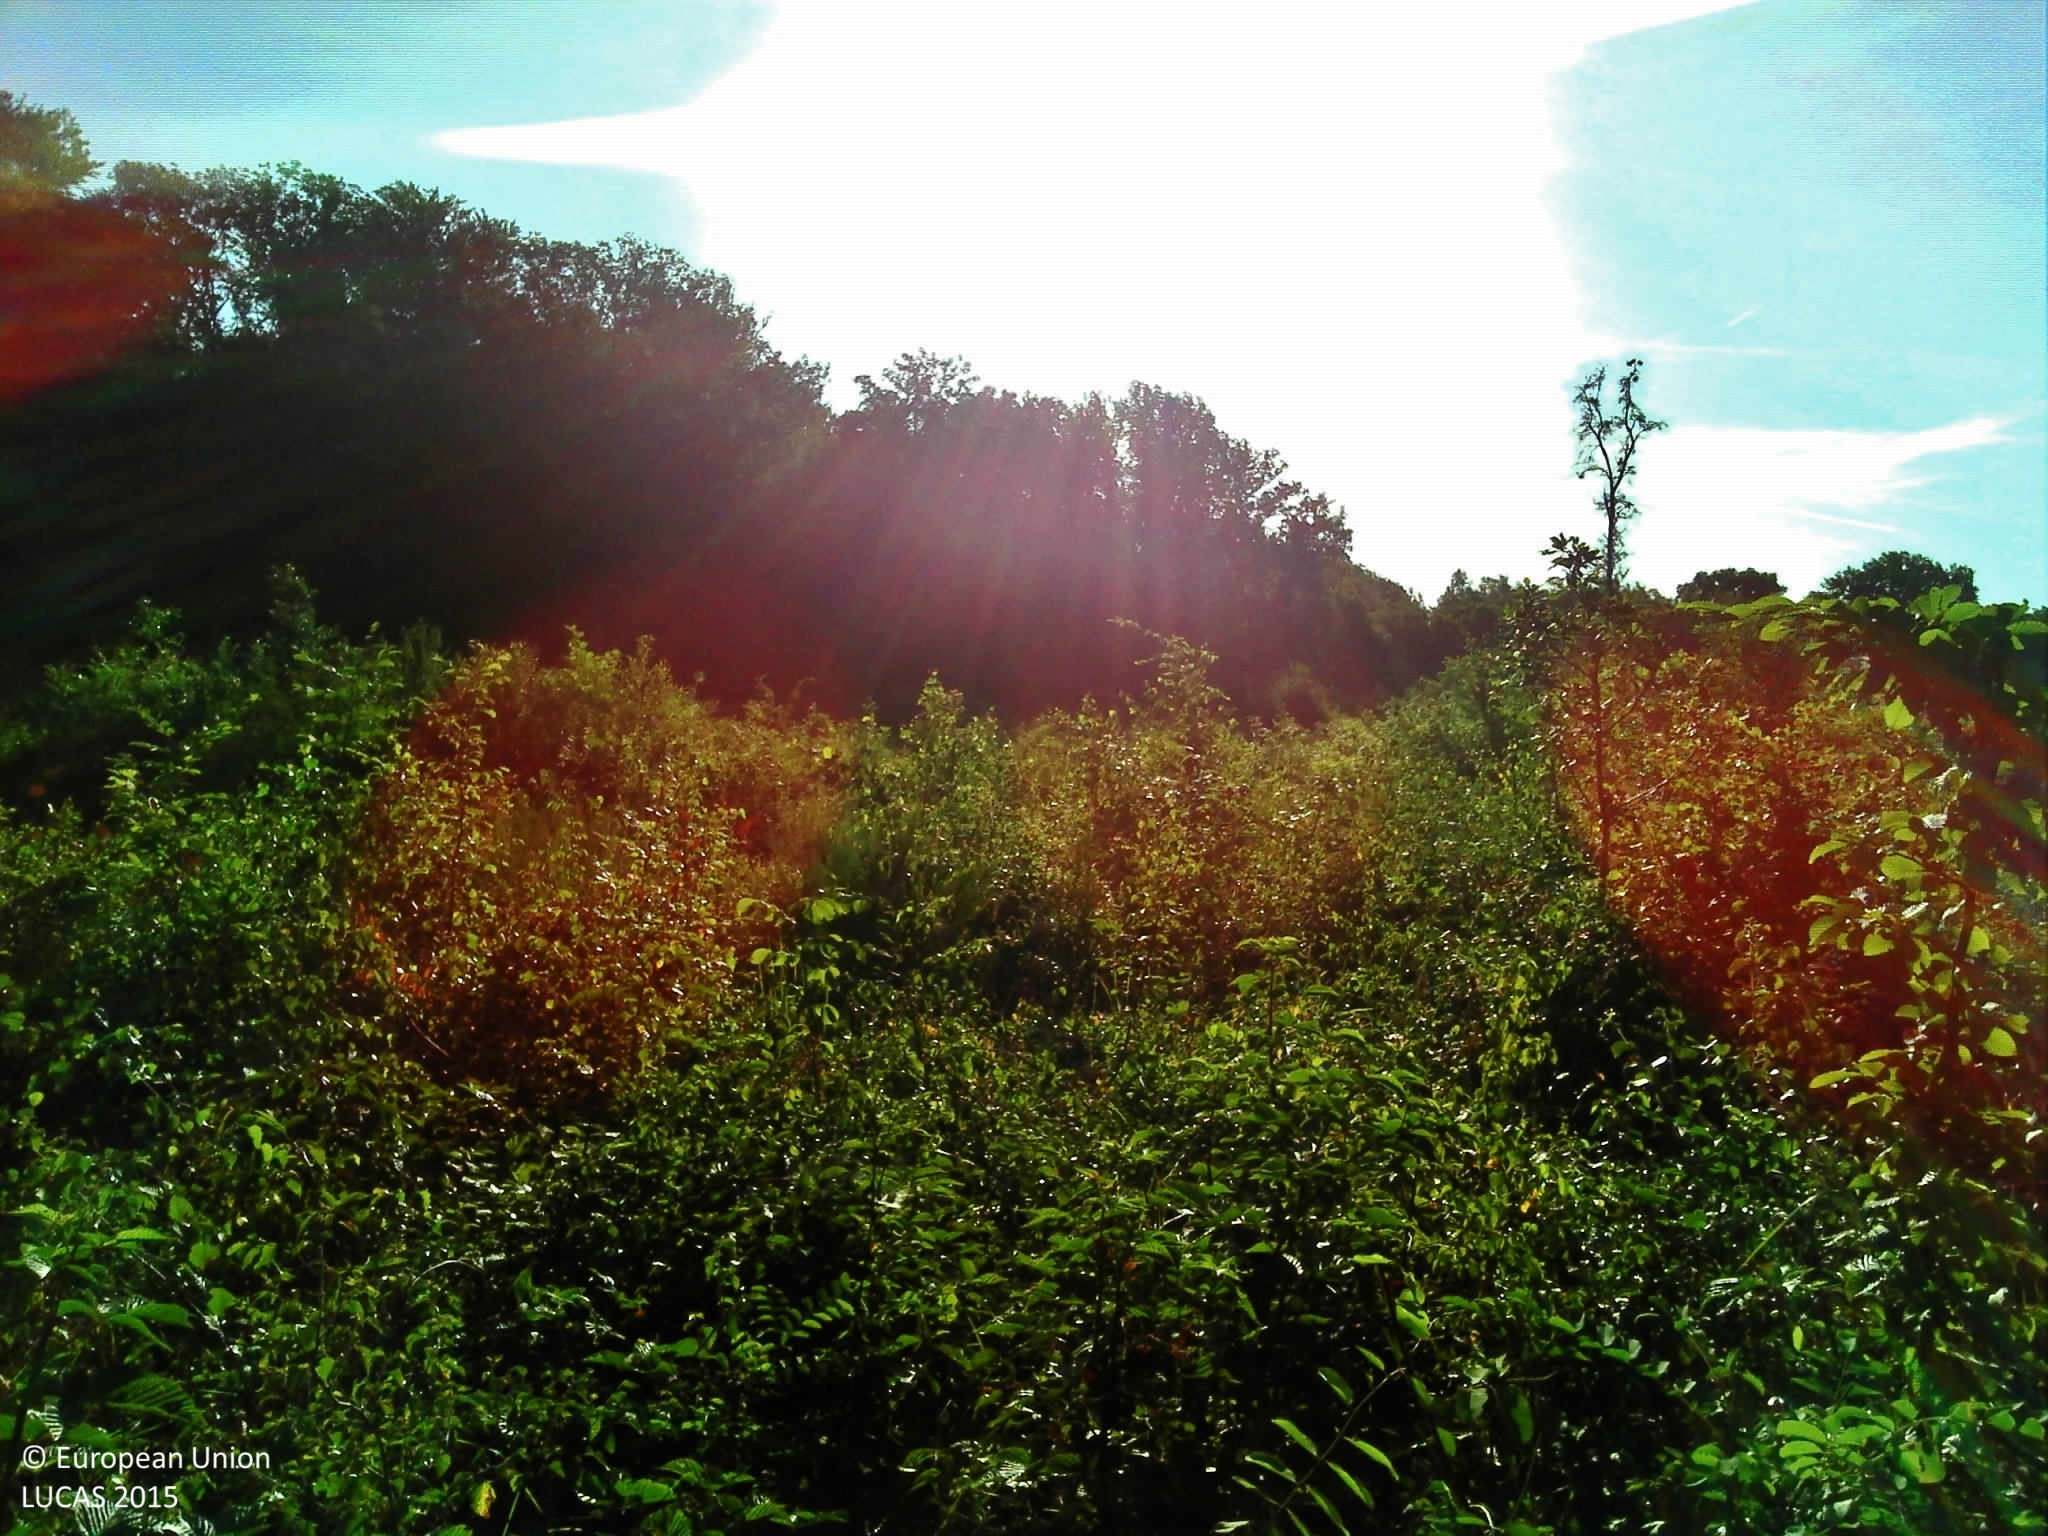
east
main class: Shrubland
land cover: Shrubland without tree cover
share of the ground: > 75 %
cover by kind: shrubs 65 %, herbaceous plants 35 %
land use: Semi-natural and natural areas not in use
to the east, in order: Shrubland without tree cover; Ditches and canals; Shrubland without tree cover; Broadleaved woodland
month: July
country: FR
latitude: 49.2741
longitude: 2.5803
